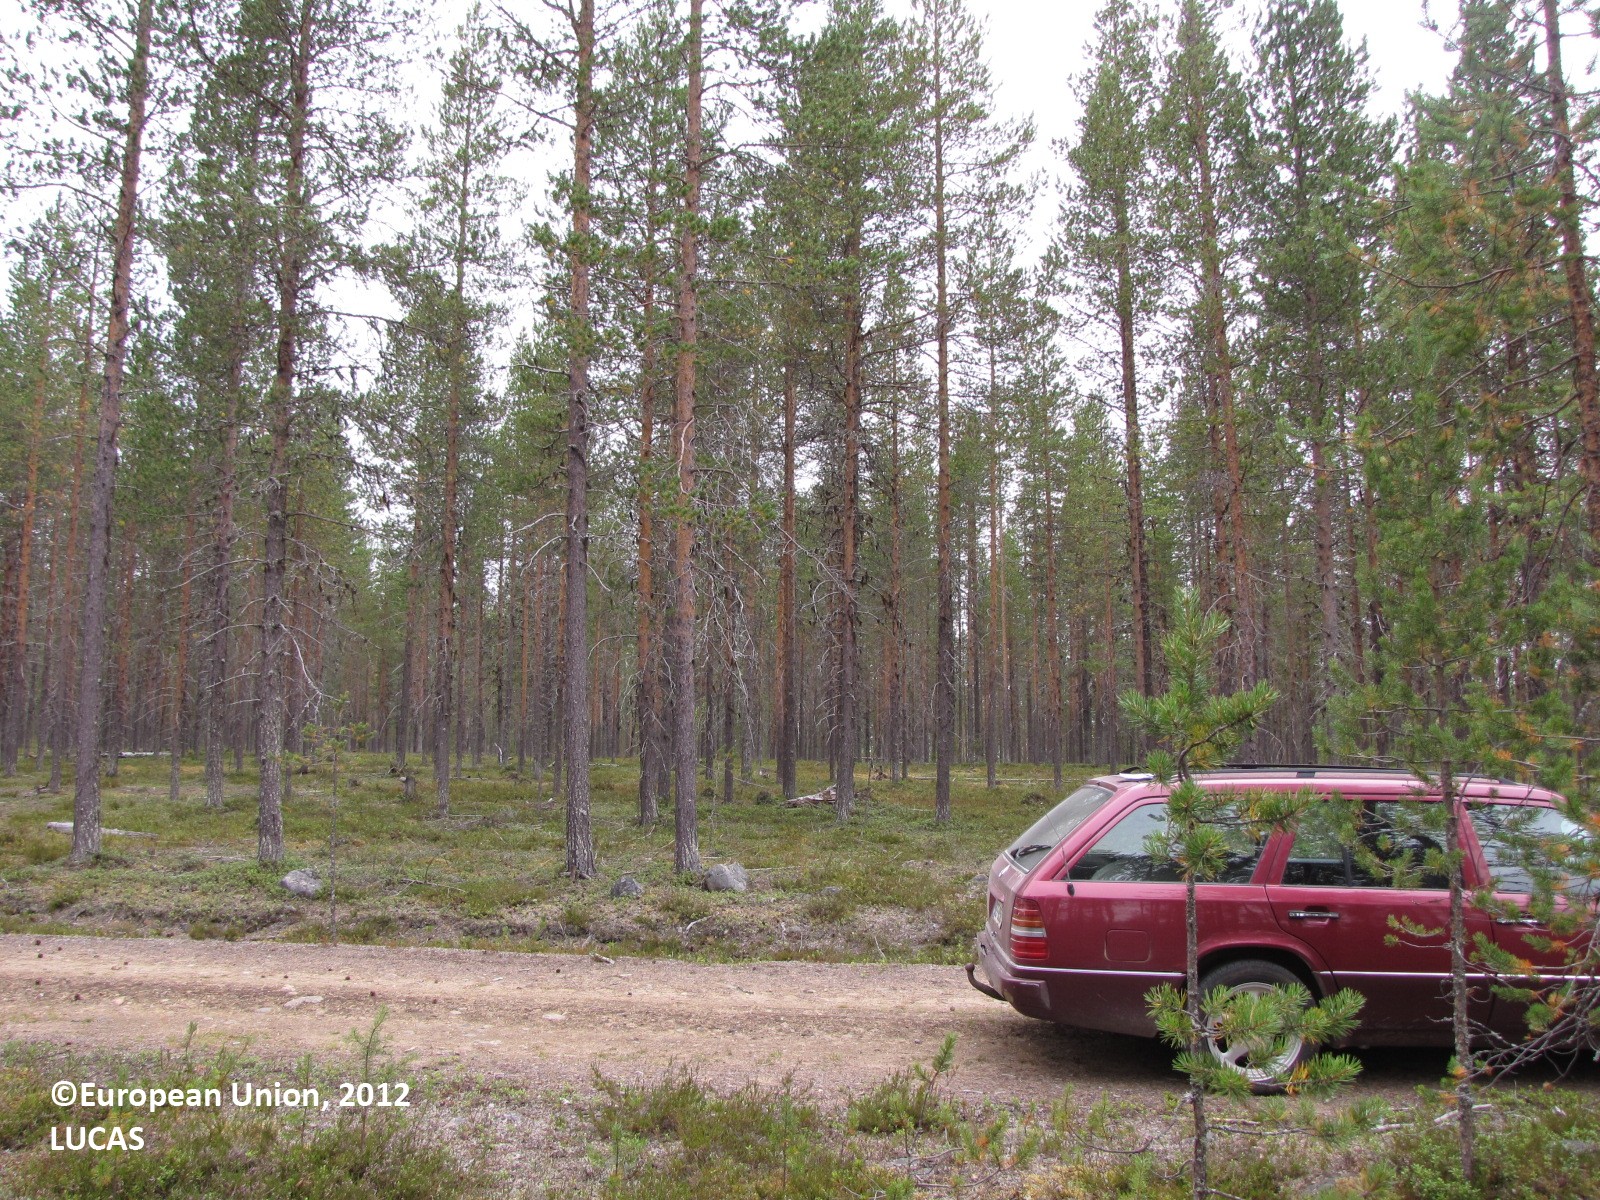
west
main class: Woodland
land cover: Pine dominated coniferous woodland
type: boreal forest
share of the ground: 25 - 50 %
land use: Forestry
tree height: > 5 m
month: August
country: FI
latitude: 67.0502
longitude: 25.1480
